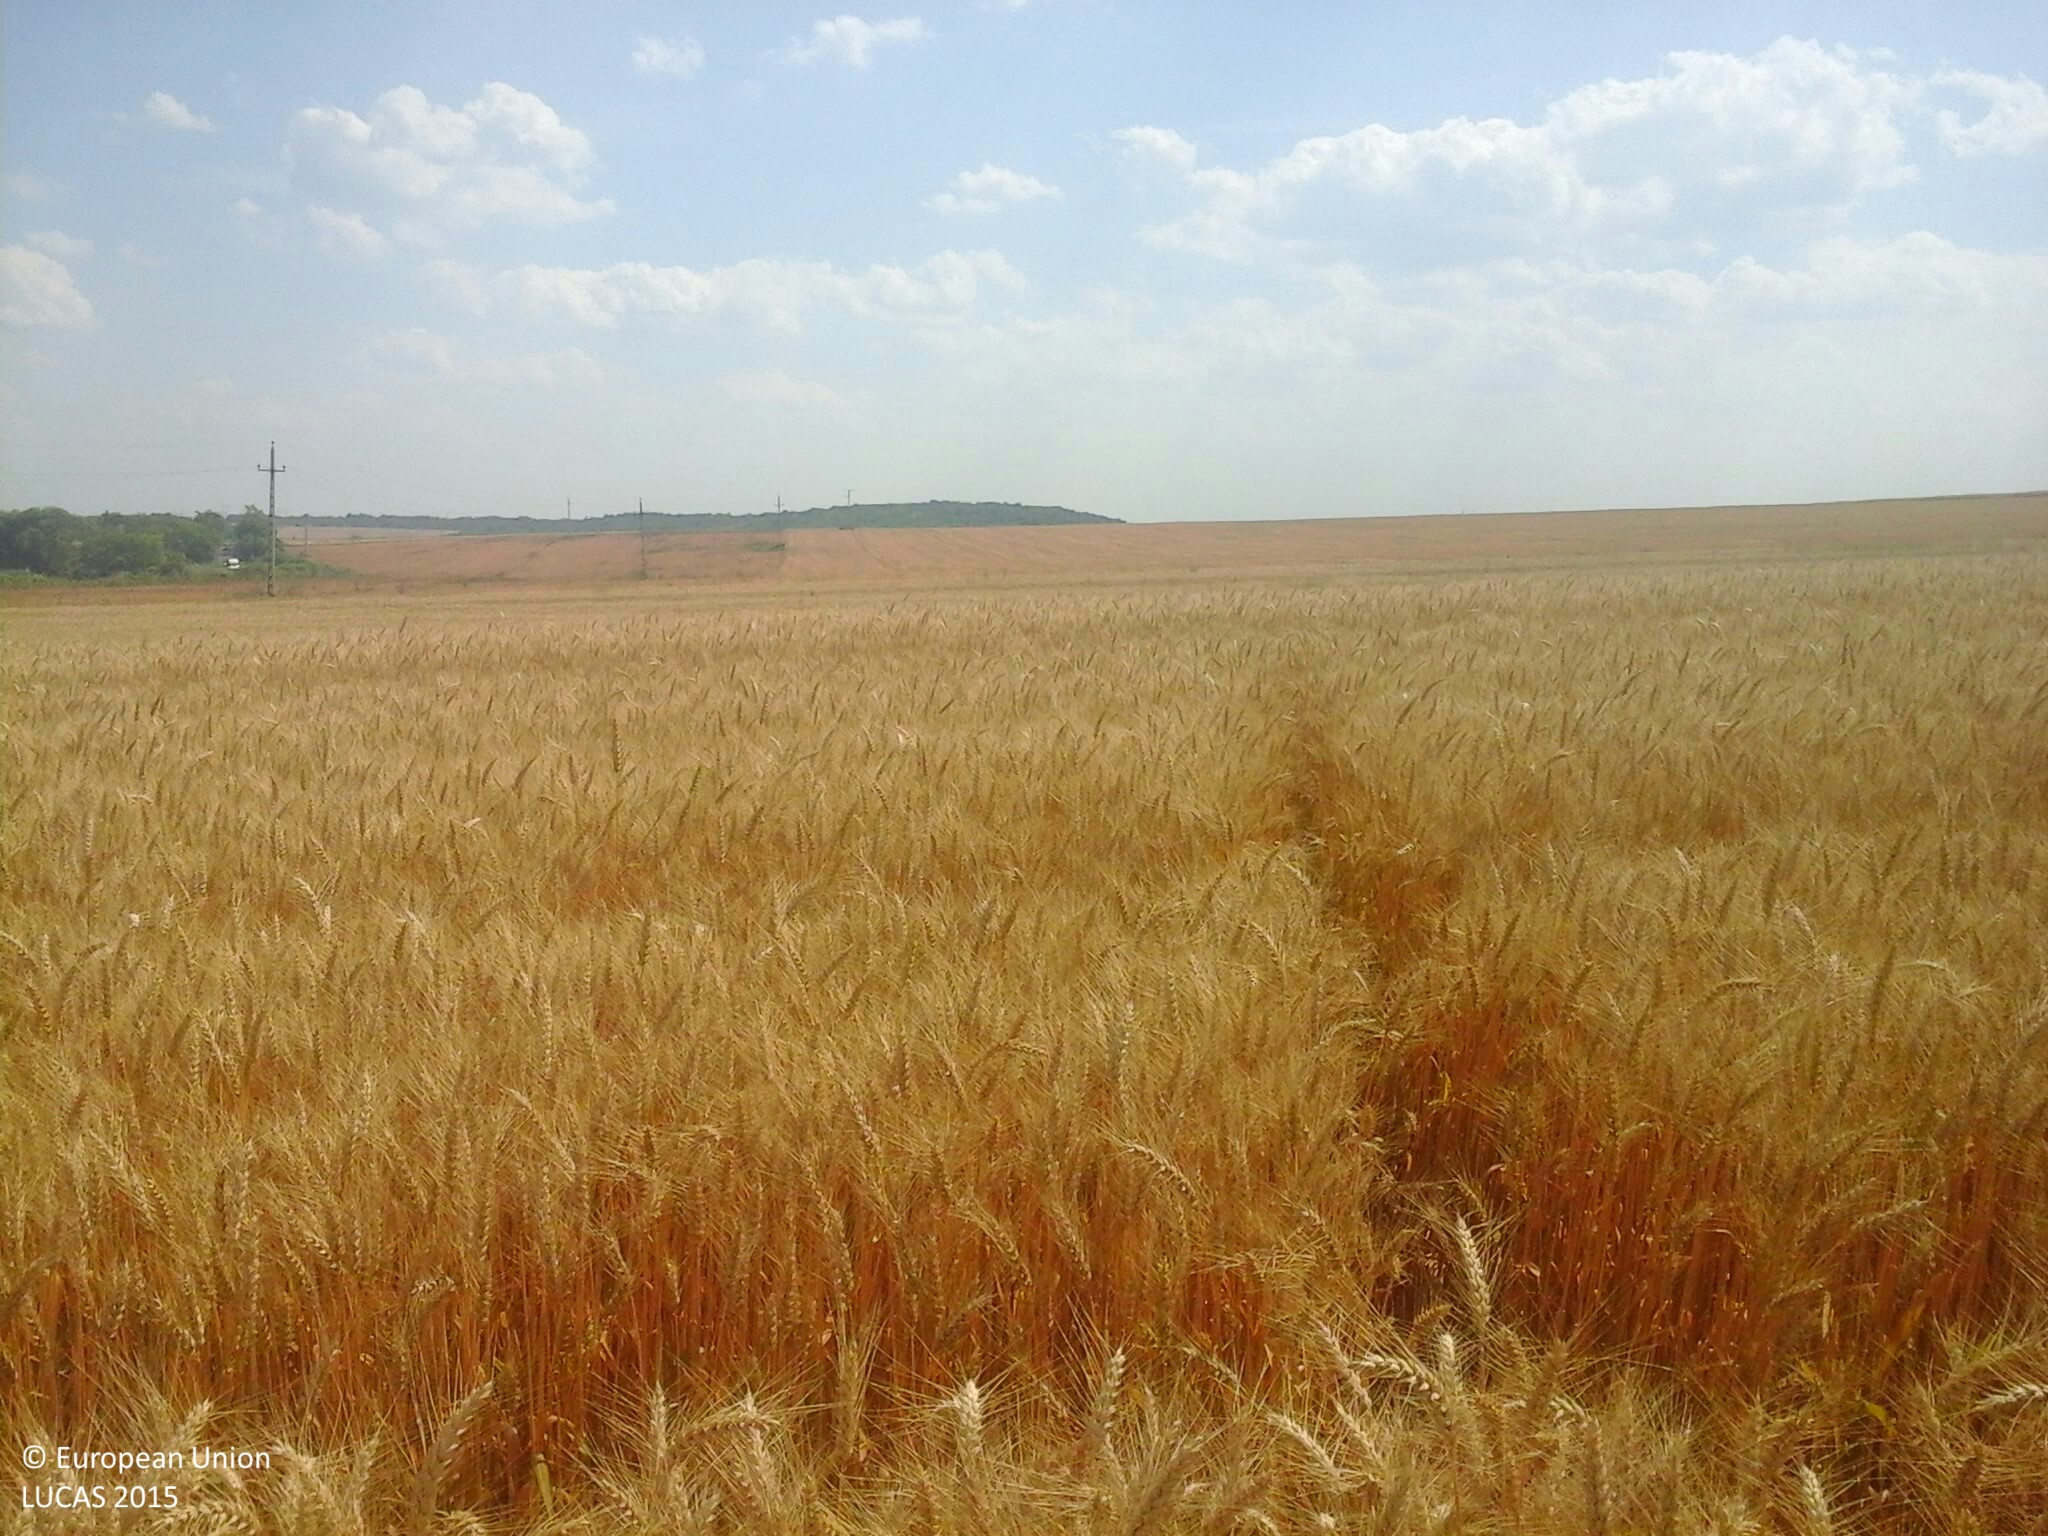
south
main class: Cropland
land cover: Common wheat
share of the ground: > 75 %
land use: Agriculture (excluding fallow land and kitchen gardens)
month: July
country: HU
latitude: 47.7825
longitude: 19.2160
